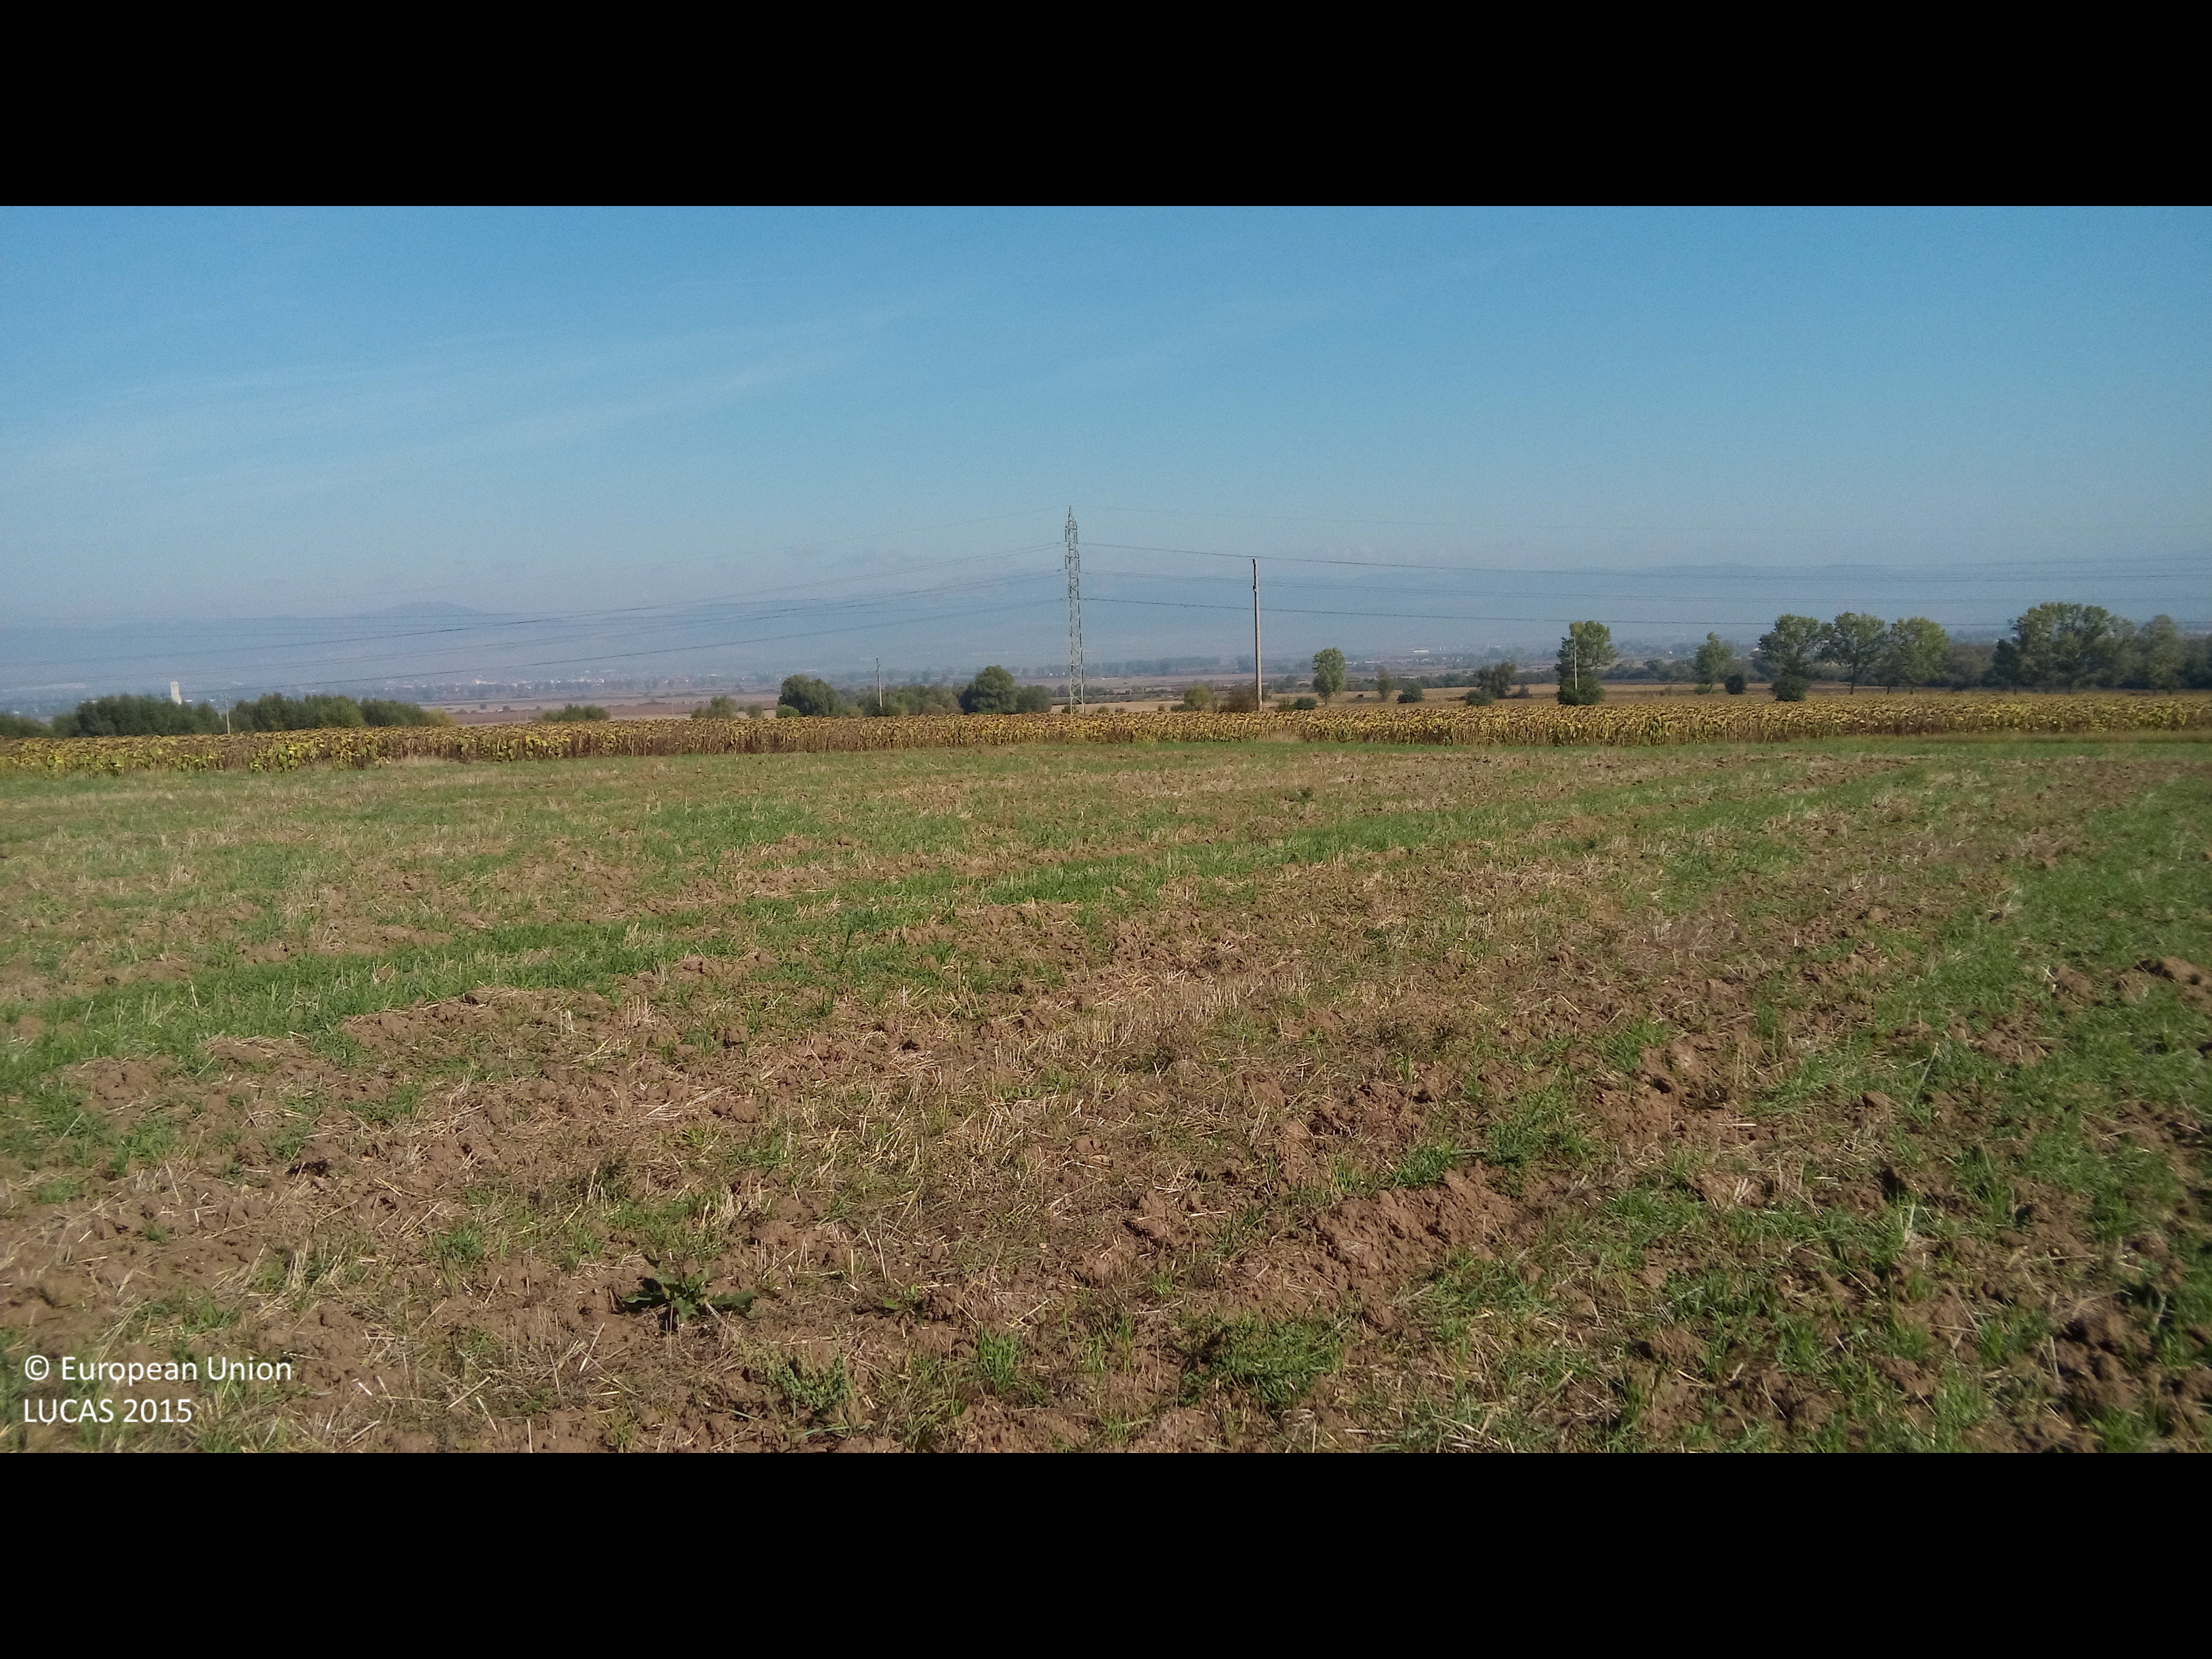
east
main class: Cropland
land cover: Common wheat
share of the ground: < 10 %
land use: Agriculture (excluding fallow land and kitchen gardens)
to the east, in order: Common wheat; Electric lines; Shrubland without tree cover; Sunflower
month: October
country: BG
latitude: 42.6090
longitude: 23.6047
